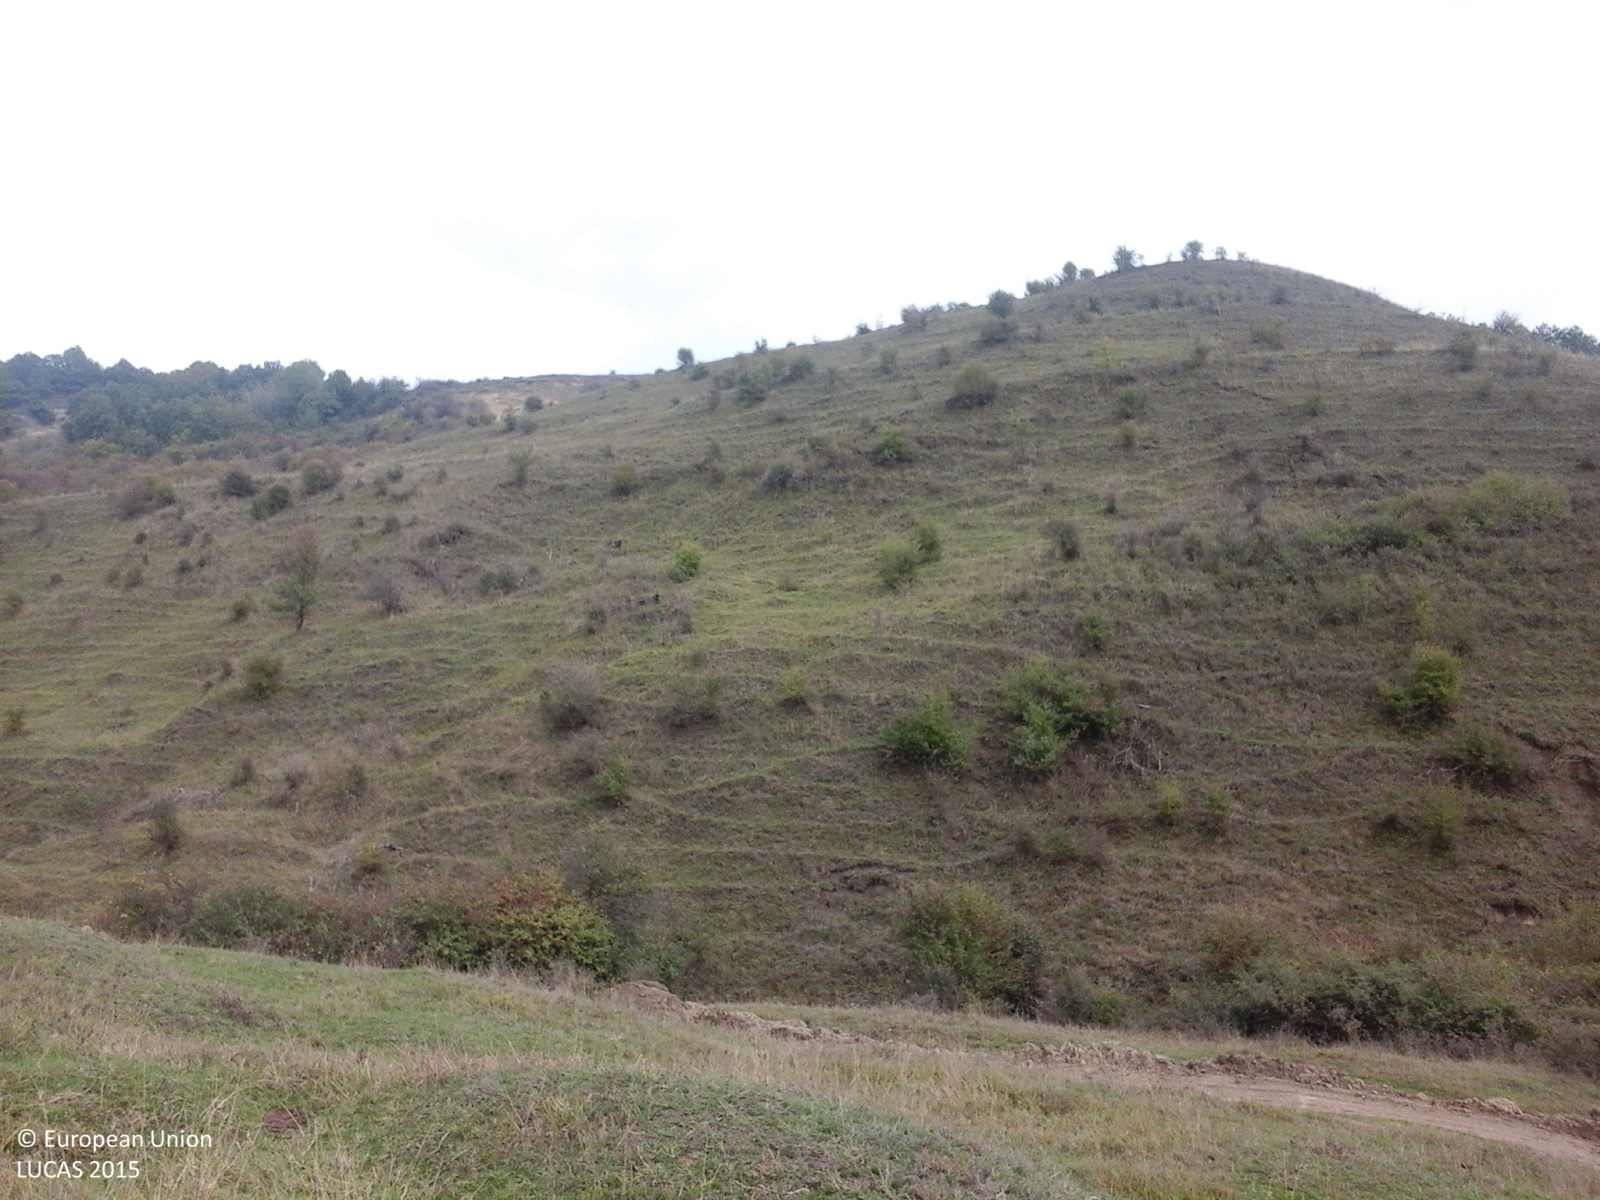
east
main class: Grassland
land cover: Grassland without tree/shrub cover
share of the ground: > 75 %
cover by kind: herbaceous plants 100 %
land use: Agriculture (excluding fallow land and kitchen gardens)
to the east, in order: Grassland without tree/shrub cover; Tracks; Grassland without tree/shrub cover; Grassland with sparse tree/shrub cover
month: October
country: RO
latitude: 46.0899
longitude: 24.0825
